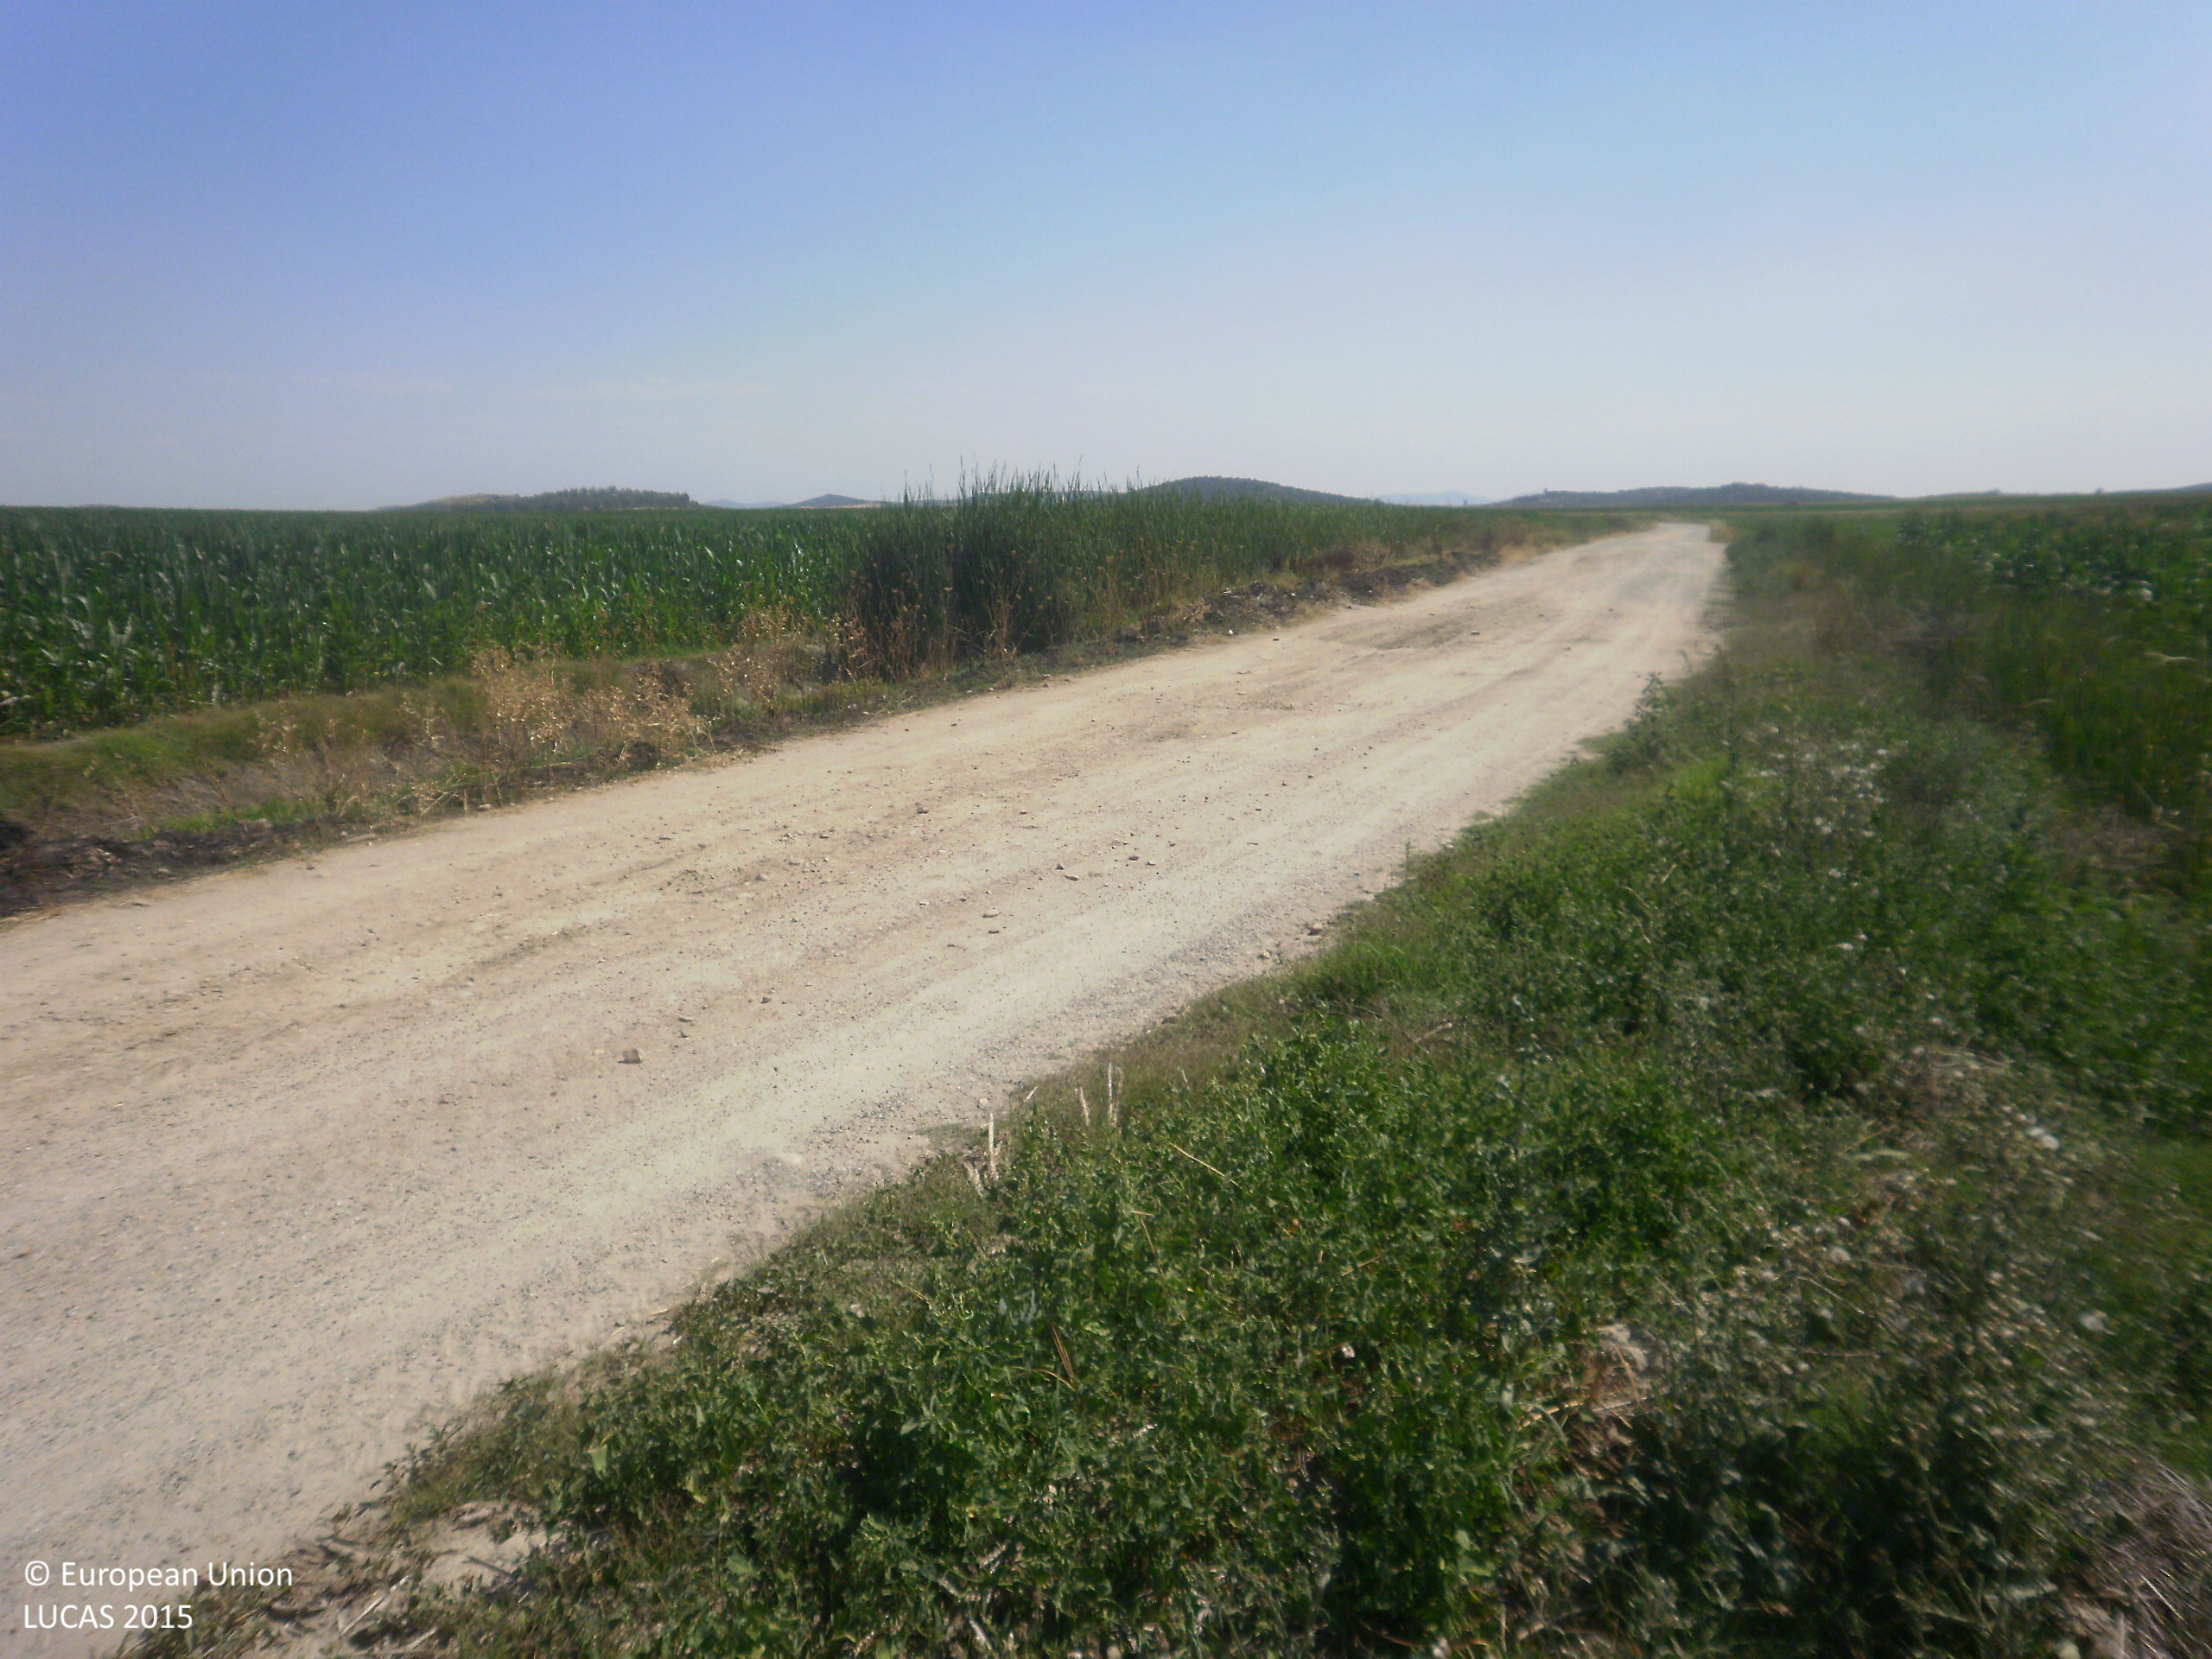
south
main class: Cropland
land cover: Maize
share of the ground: > 75 %
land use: Agriculture (excluding fallow land and kitchen gardens)
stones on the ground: < 10 %
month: June
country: ES
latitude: 39.0569
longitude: -5.9890
